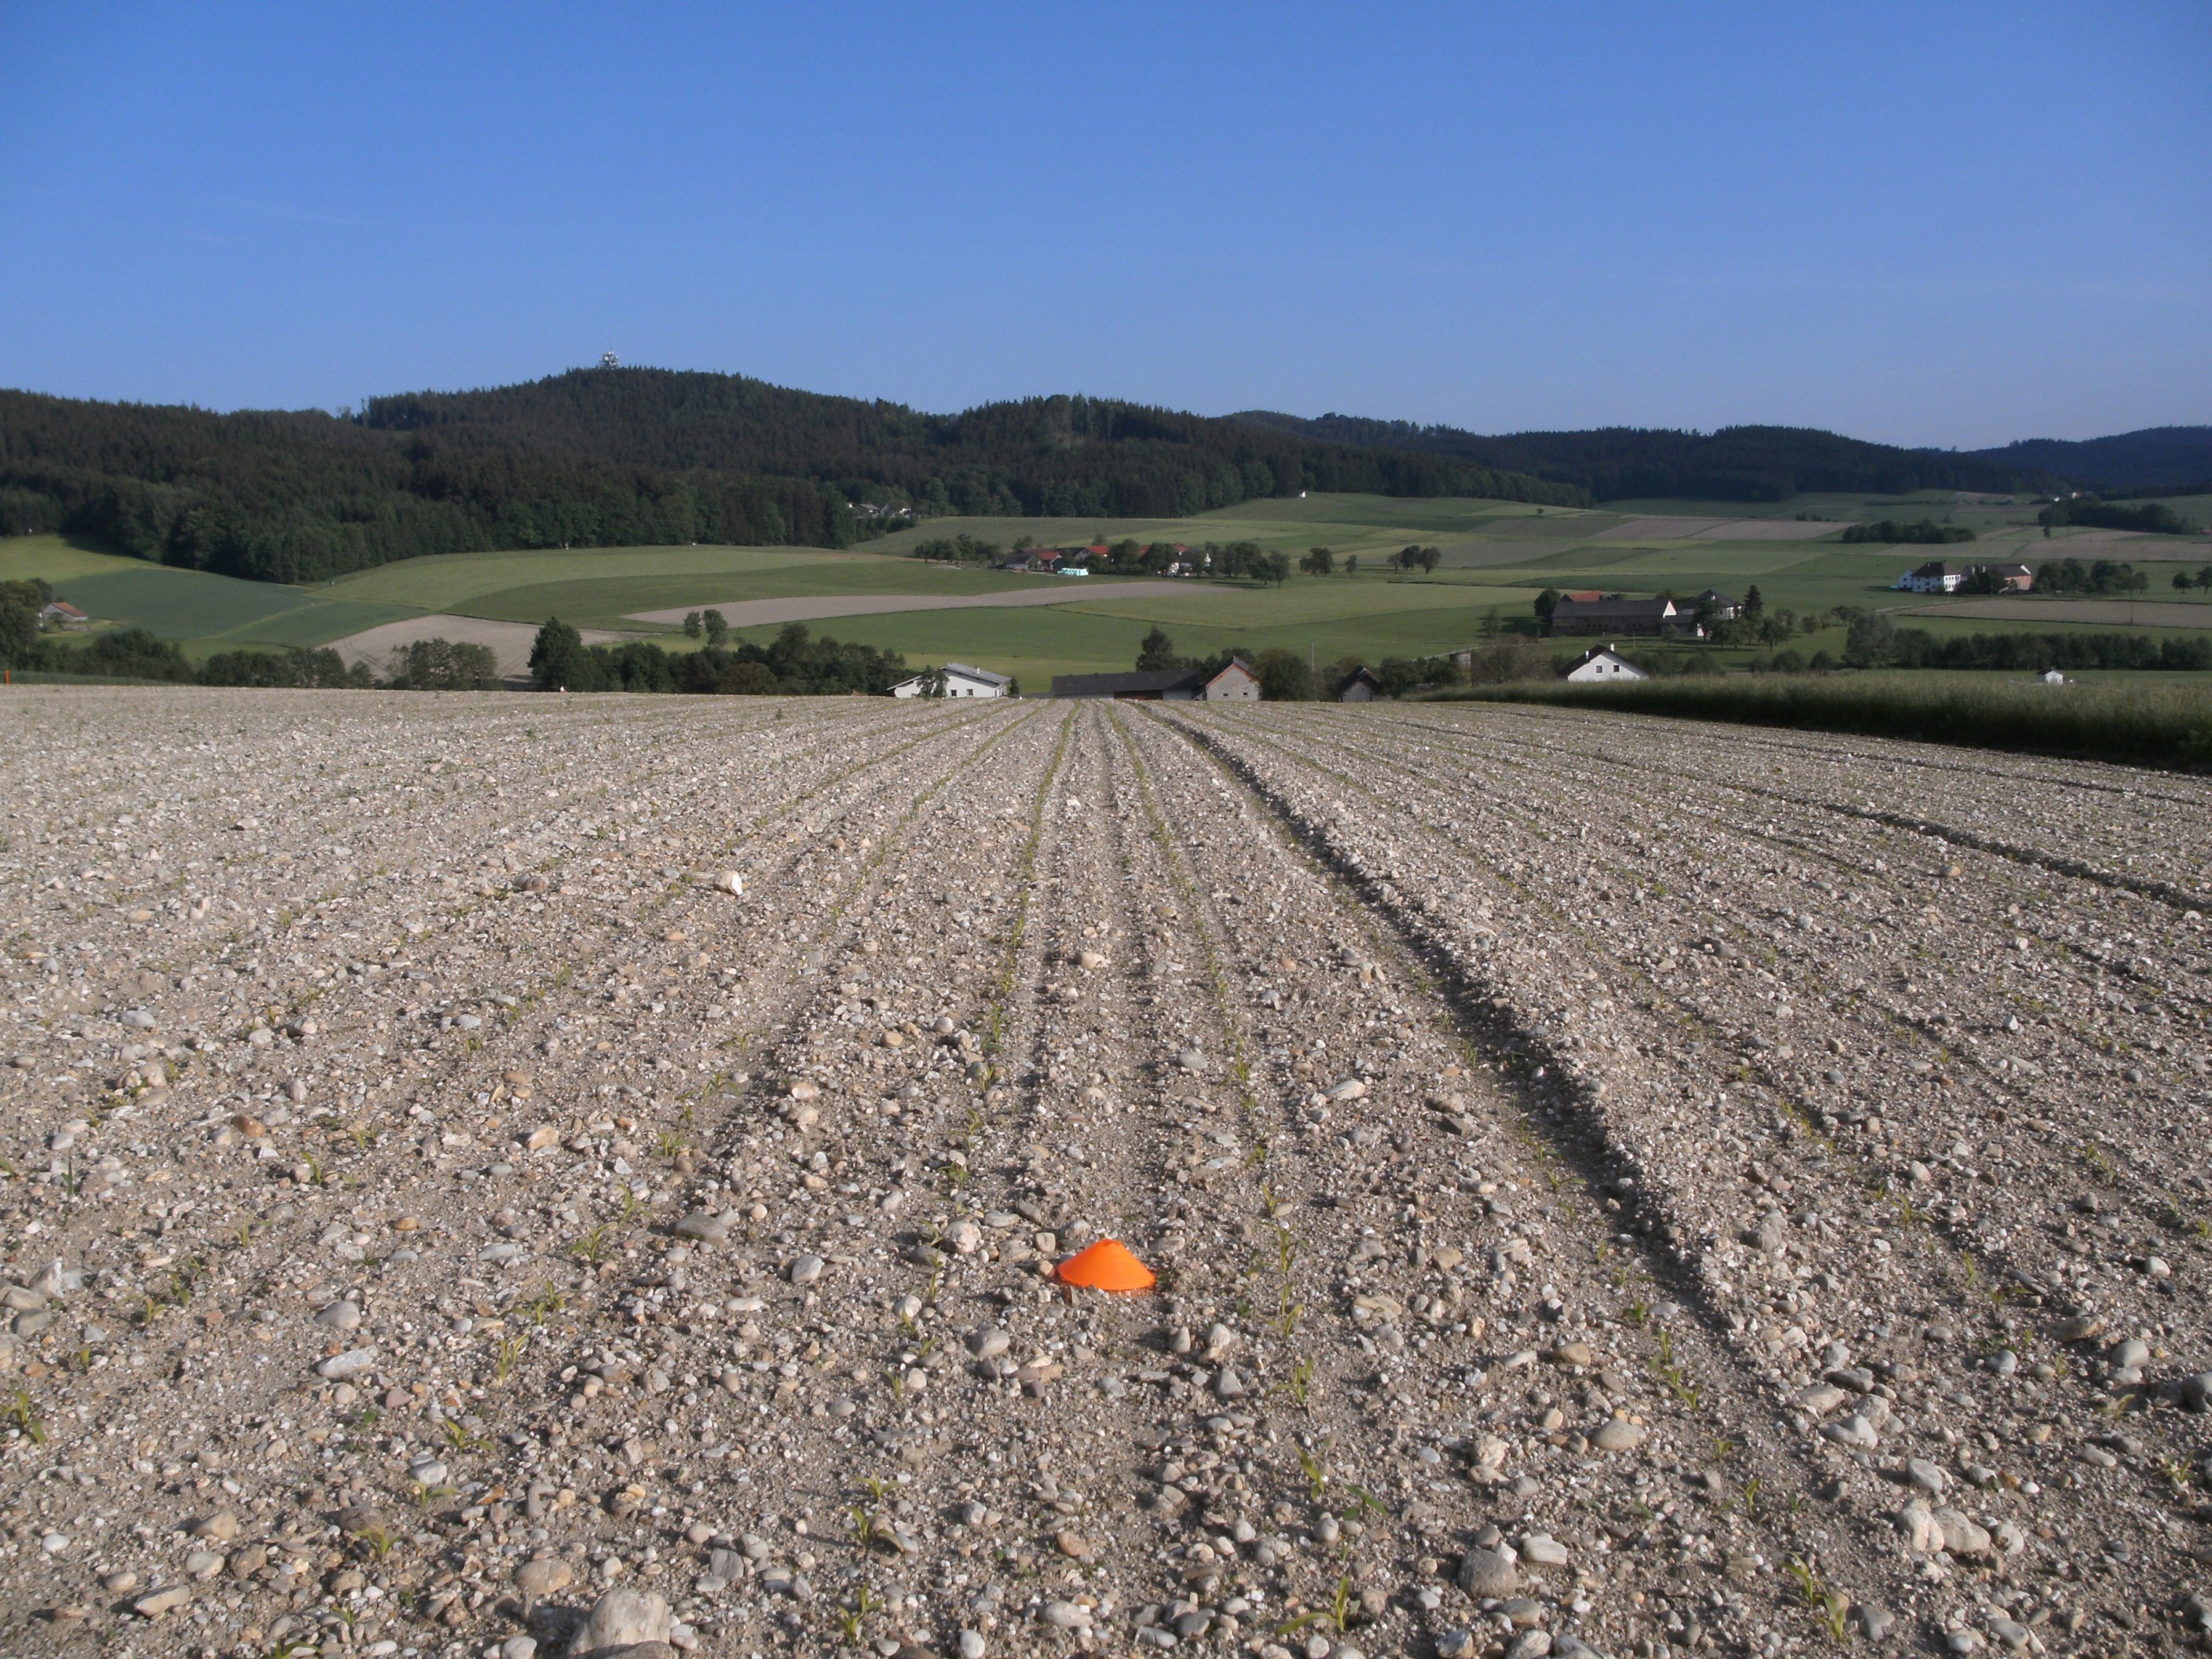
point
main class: Cropland
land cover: Maize
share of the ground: < 10 %
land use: Agriculture (excluding fallow land and kitchen gardens)
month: May
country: AT
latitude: 48.1651
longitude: 13.5892
